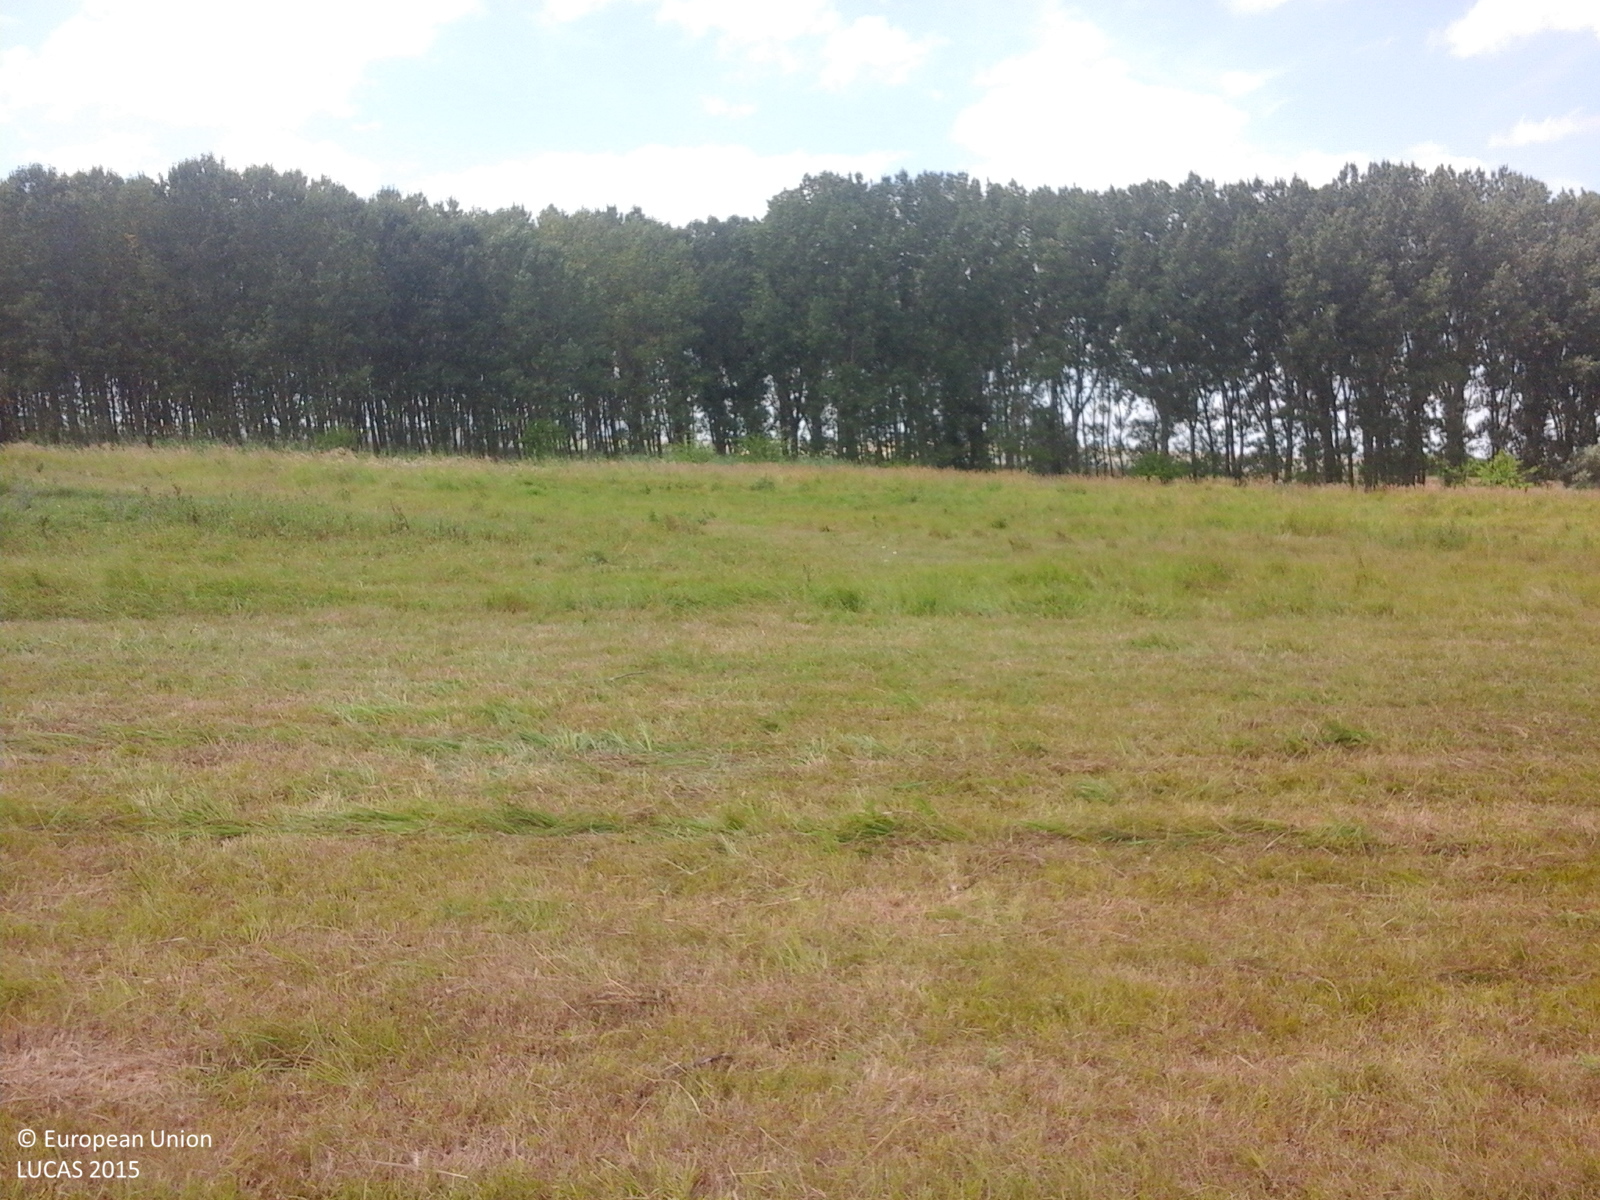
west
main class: Grassland
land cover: Grassland without tree/shrub cover
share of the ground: > 75 %
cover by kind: herbaceous plants 100 %
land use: Agriculture (excluding fallow land and kitchen gardens)
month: July
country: RO
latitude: 46.4616
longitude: 28.2465
